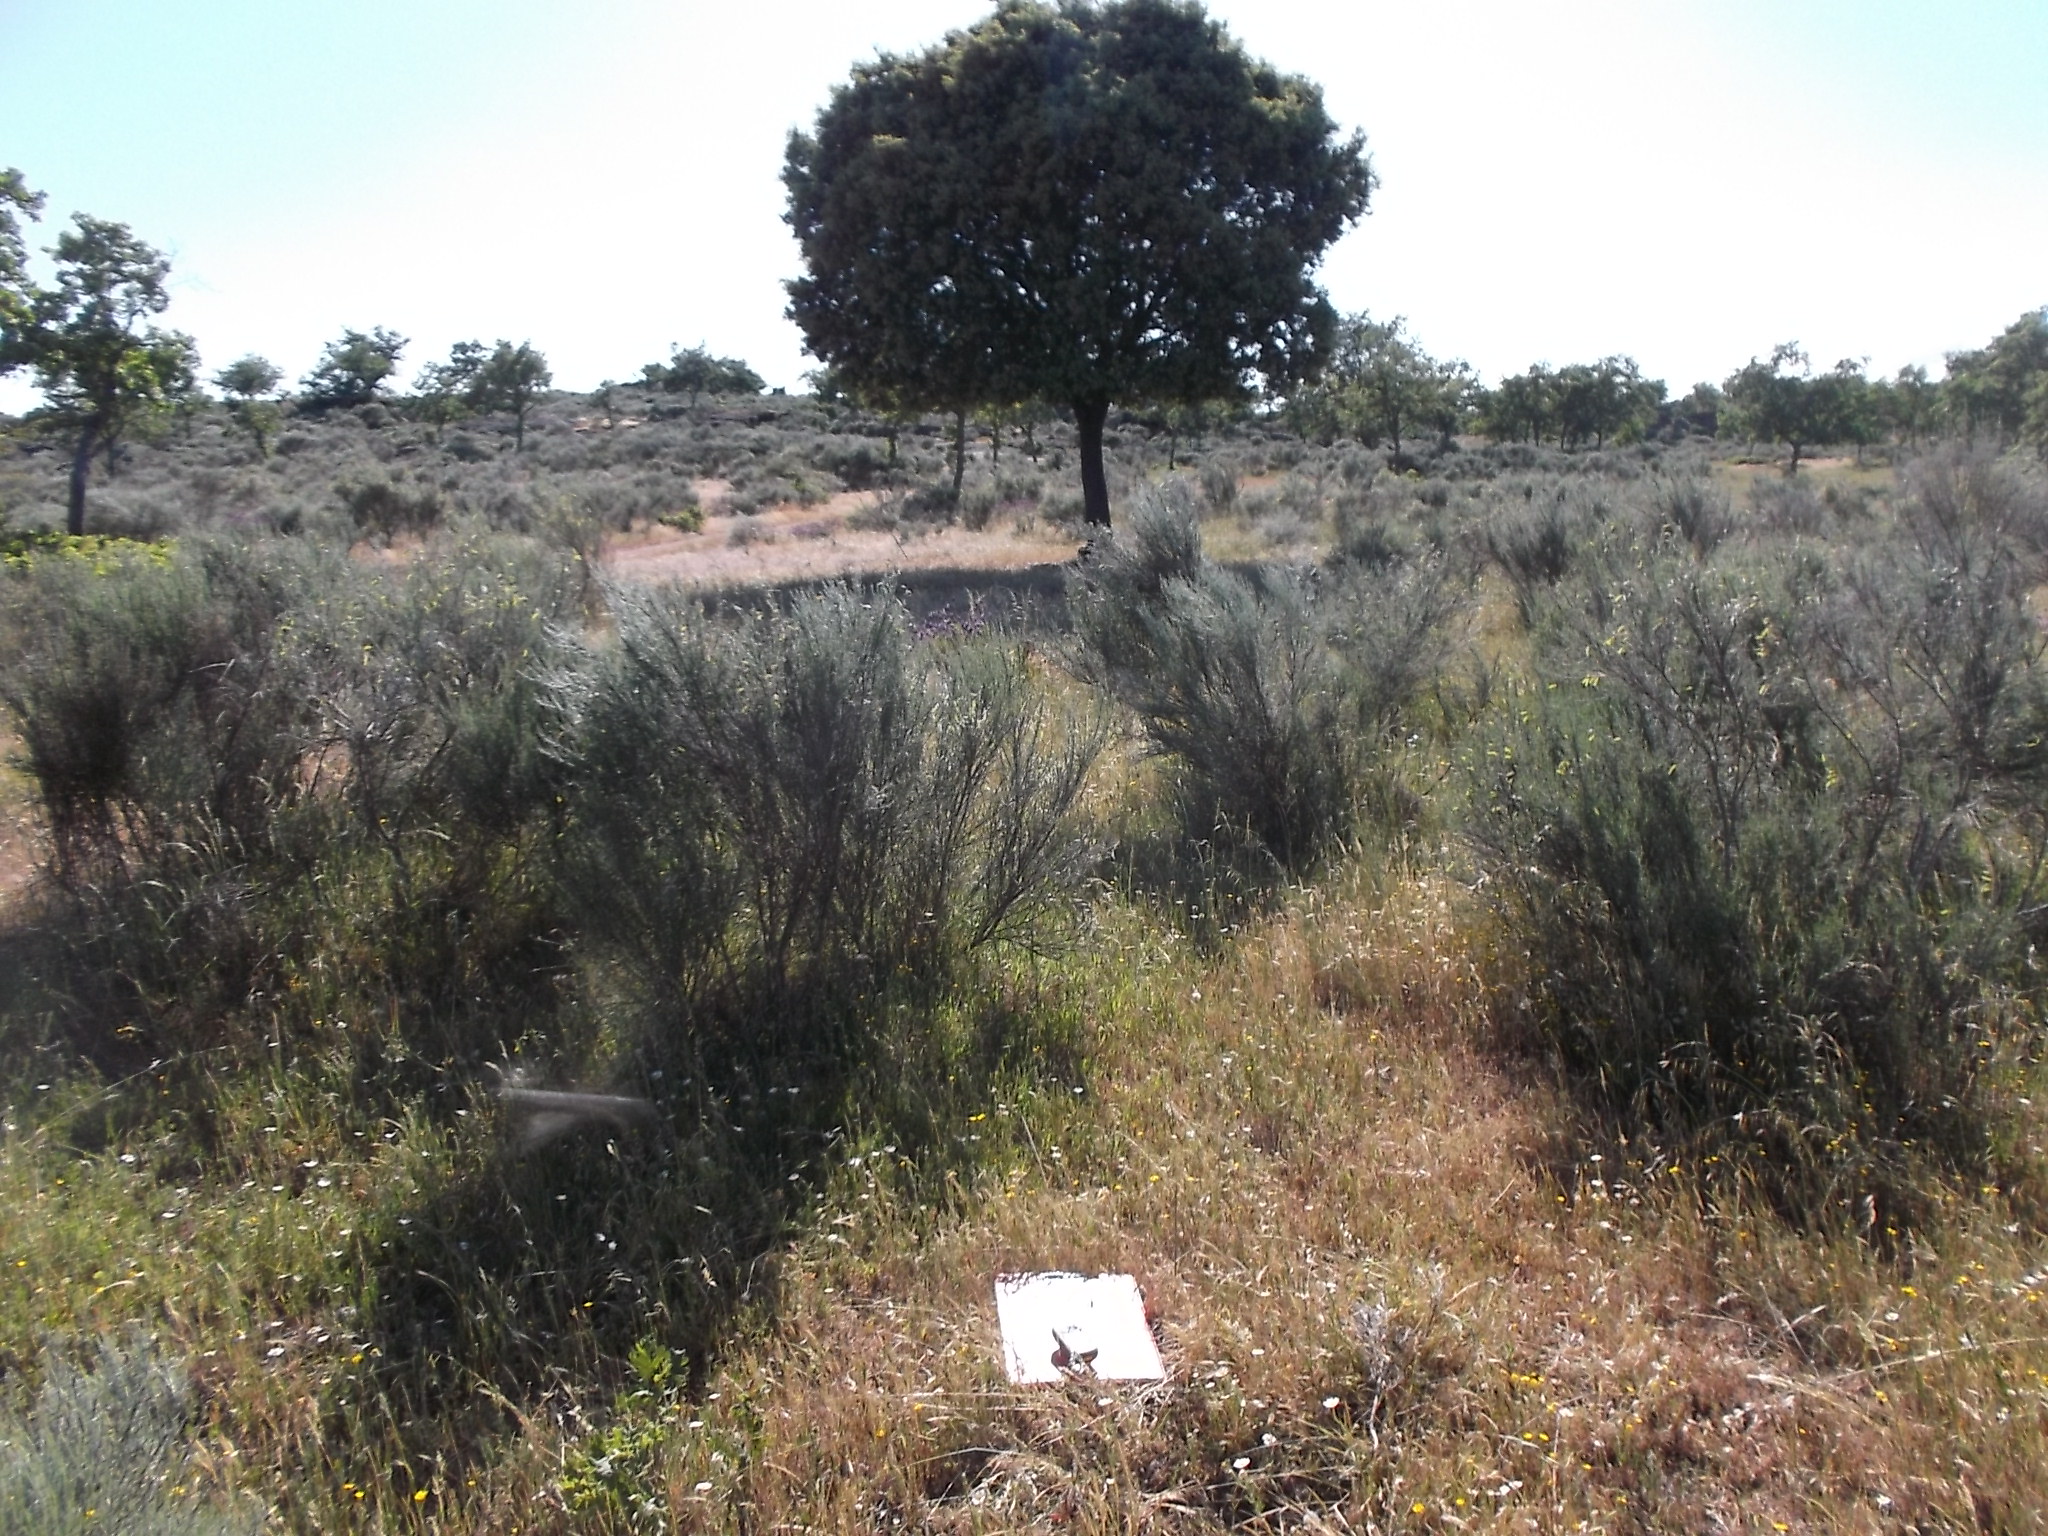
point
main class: Grassland
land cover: Grassland with sparse tree/shrub cover
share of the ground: > 75 %
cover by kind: herbaceous plants 90 %, broadleaved forest trees 5 %, shrubs 5 %
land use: Agriculture (excluding fallow land and kitchen gardens)
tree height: < 5 m
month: May
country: ES
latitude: 40.9972
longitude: -6.2697
